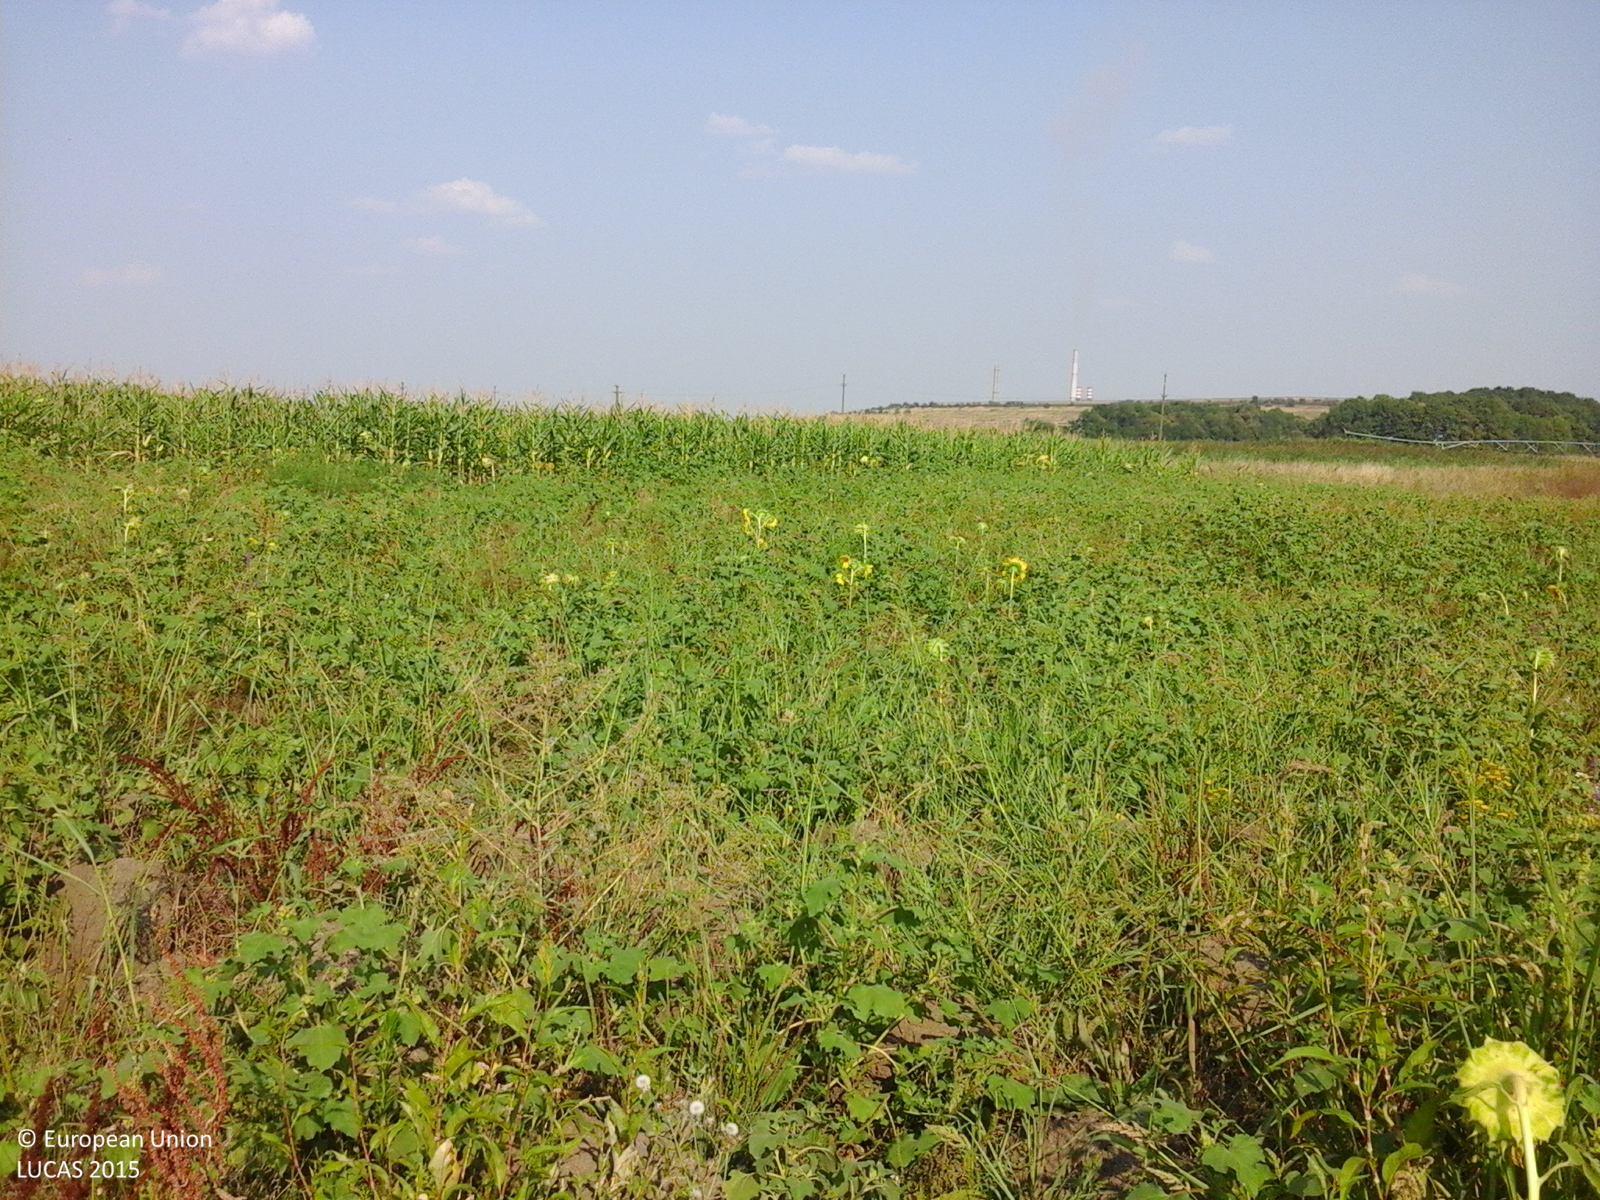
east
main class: Grassland
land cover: Spontaneously vegetated surfaces
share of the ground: > 75 %
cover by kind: herbaceous plants 100 %
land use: Agriculture (excluding fallow land and kitchen gardens)
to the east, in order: Spontaneously vegetated surfaces; Maize; Spontaneously vegetated surfaces; Sunflower
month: August
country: RO
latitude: 44.3903
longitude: 23.6758
